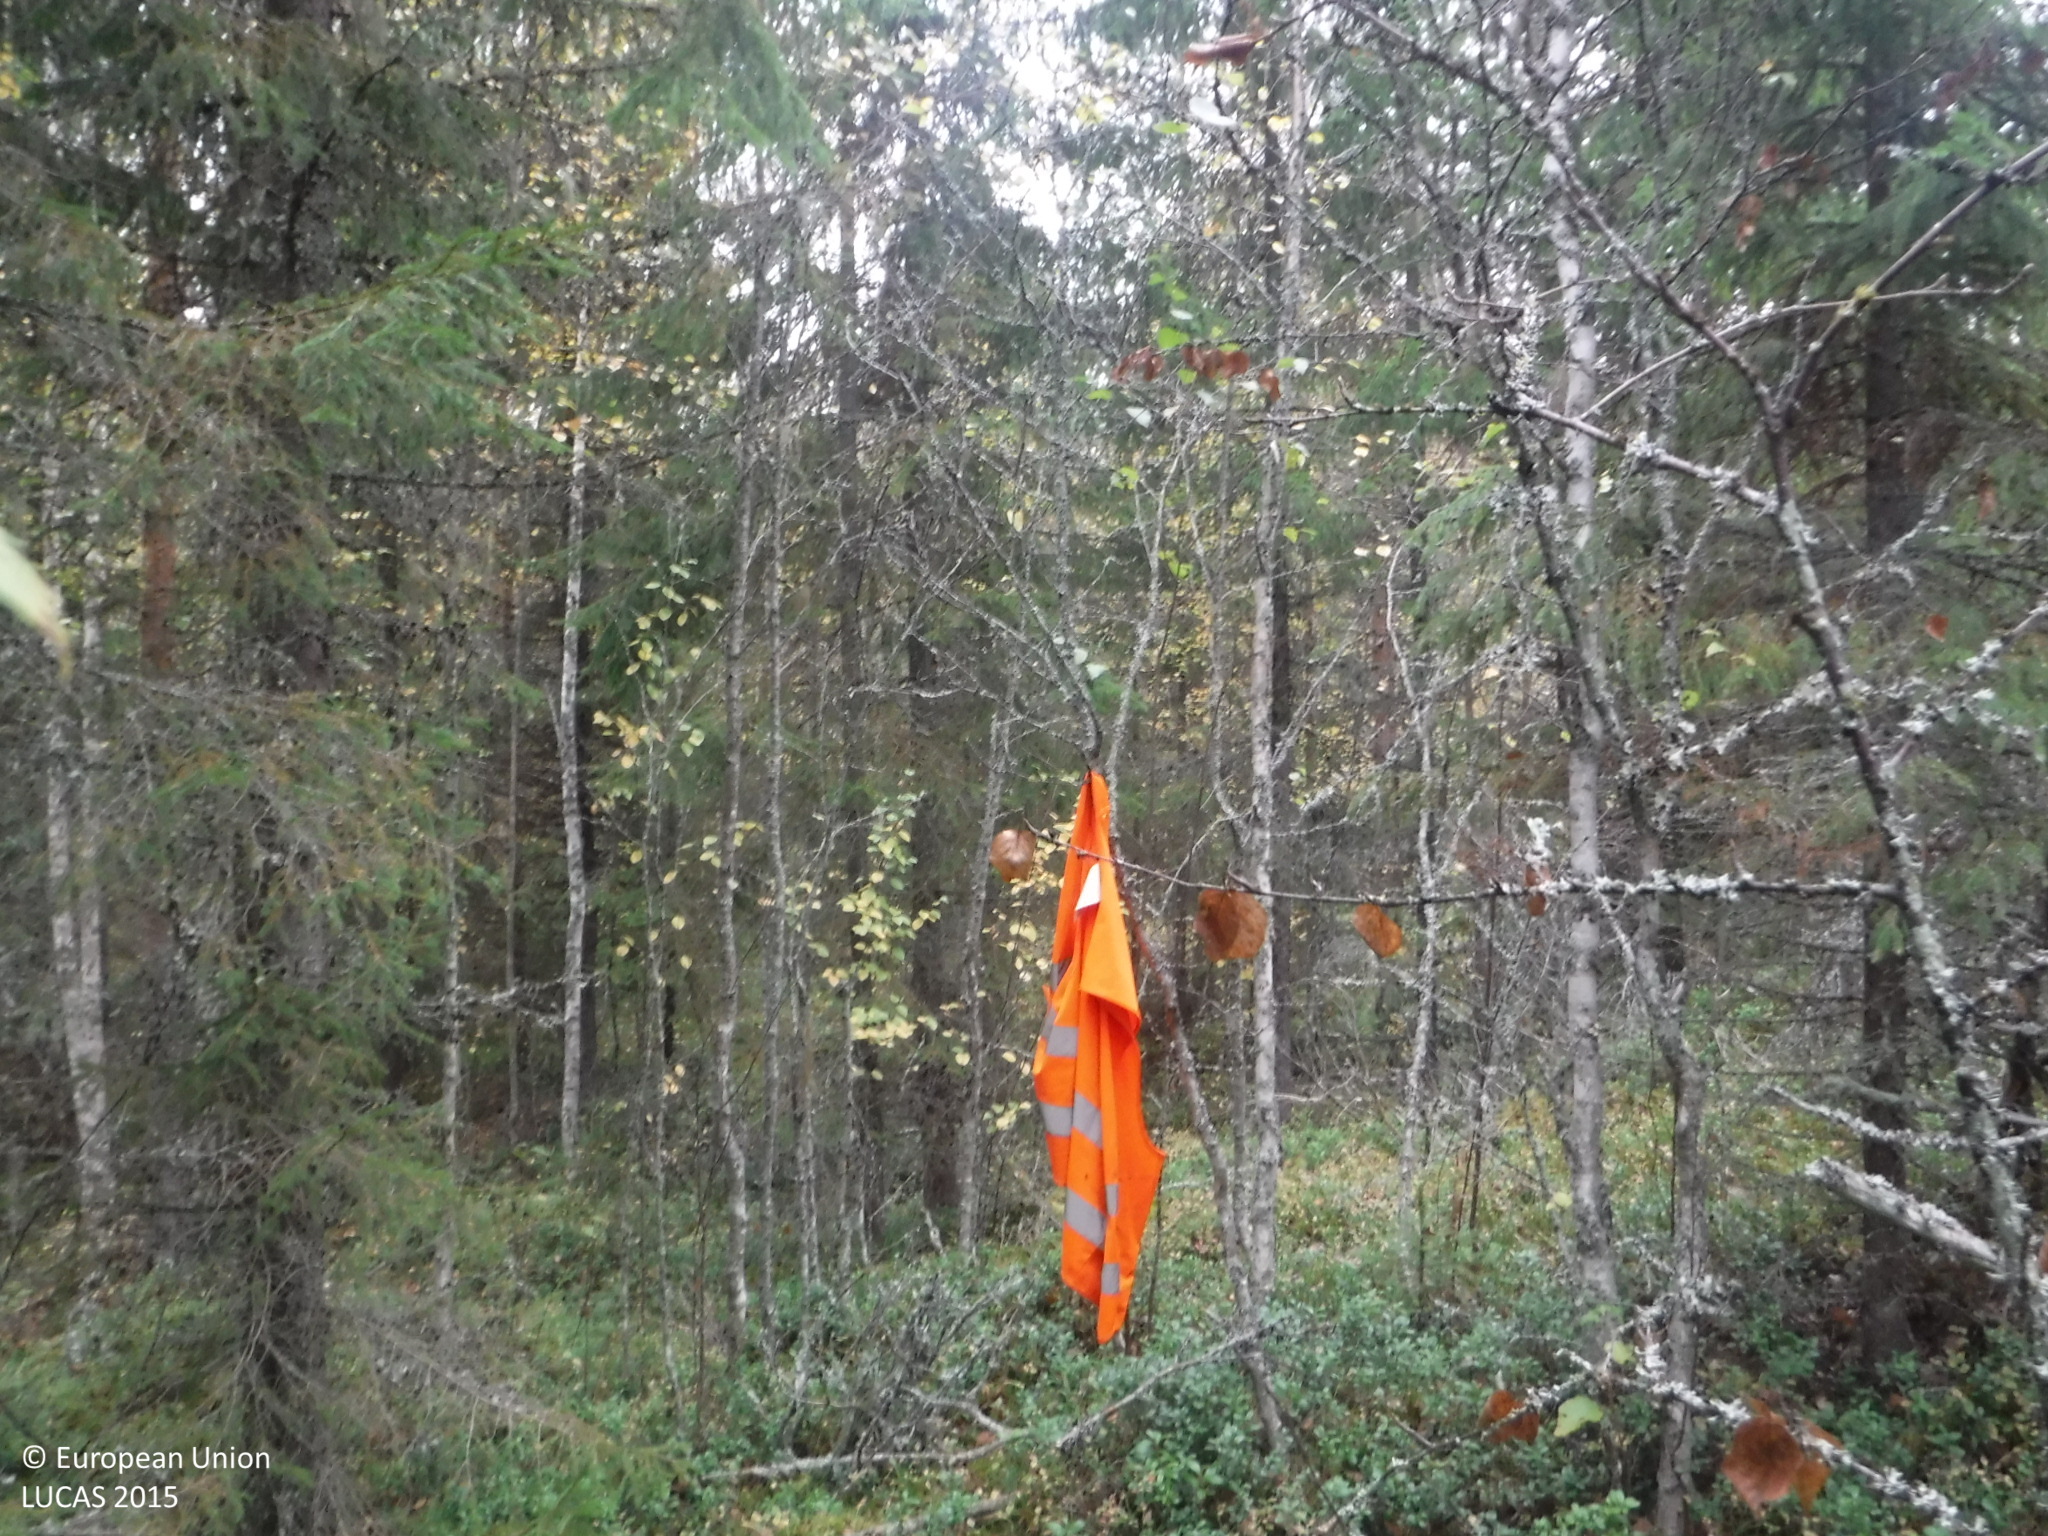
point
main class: Woodland
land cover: Spruce dominated mixed woodland
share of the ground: 50 - 75 %
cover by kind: coniferous forest trees 40 %, broadleaved forest trees 30 %, shrubs 20 %, lichens and mosses 10 %
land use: Forestry
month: September
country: FI
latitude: 61.6737
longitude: 24.0493
